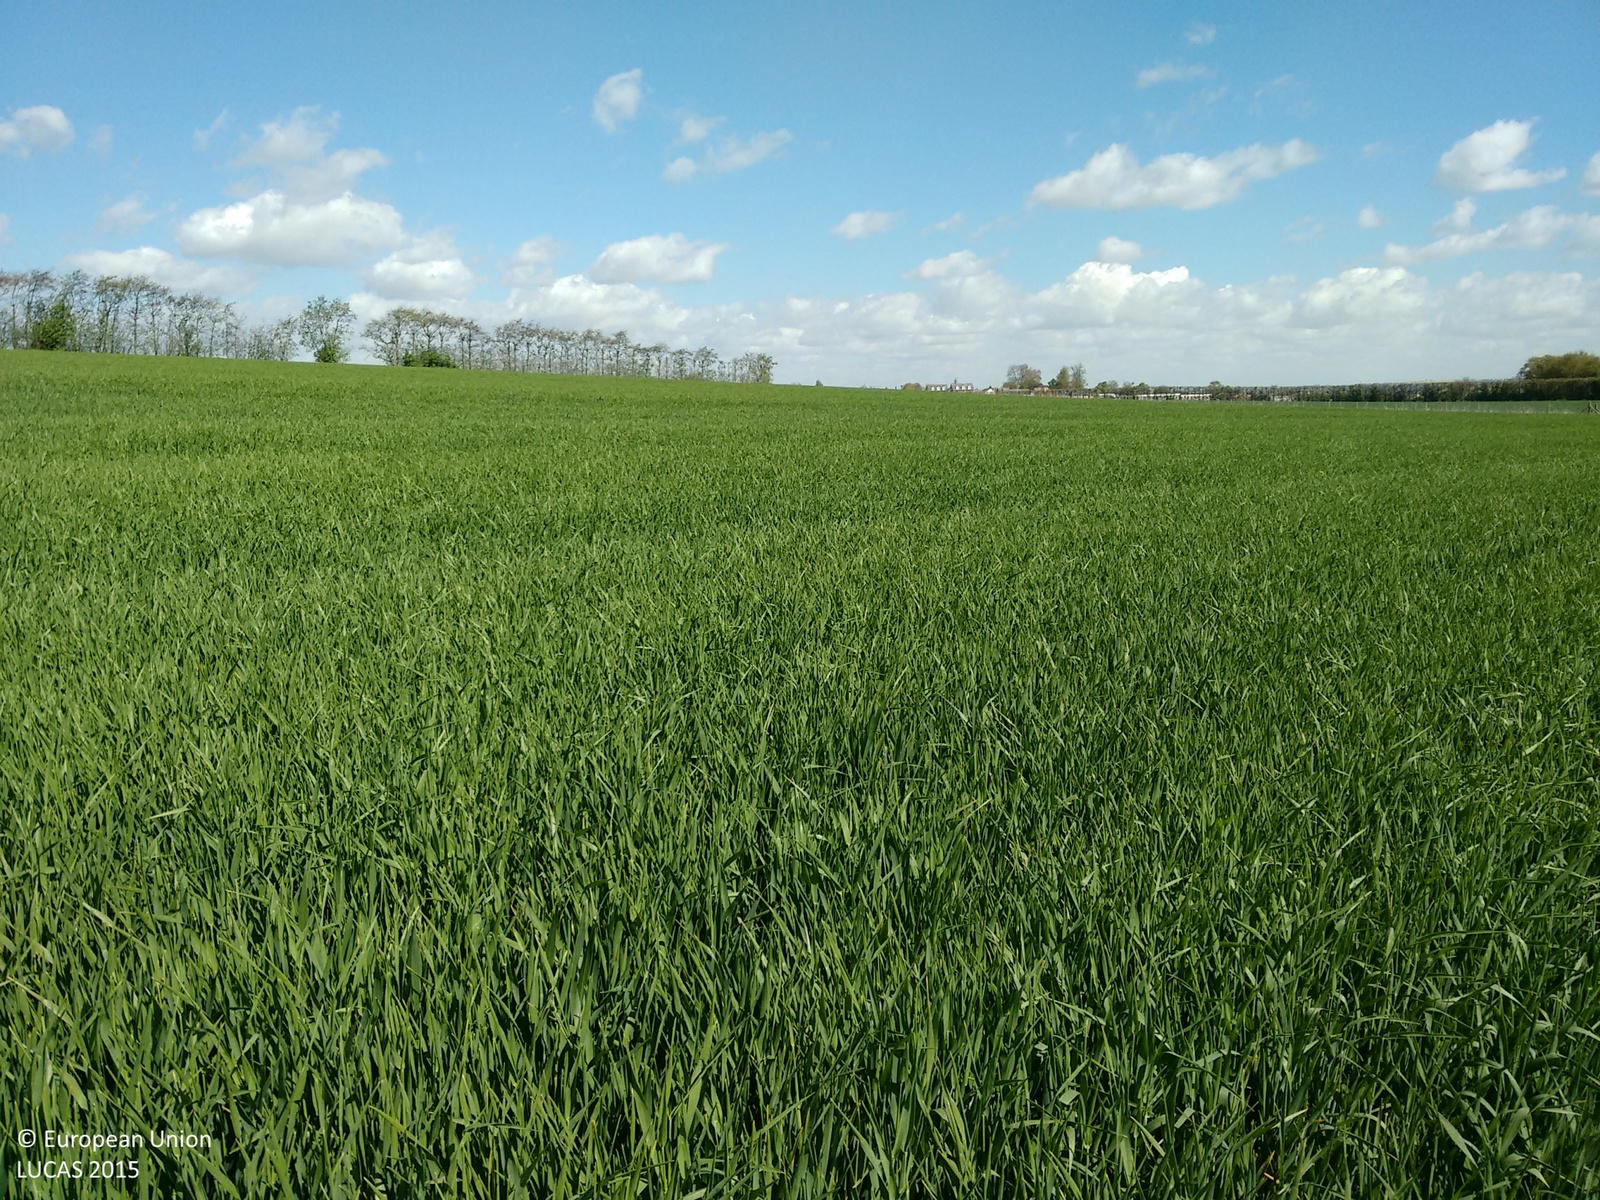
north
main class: Cropland
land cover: Barley
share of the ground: > 75 %
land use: Agriculture (excluding fallow land and kitchen gardens)
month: April
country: GB
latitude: 51.3276
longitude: 0.7465
